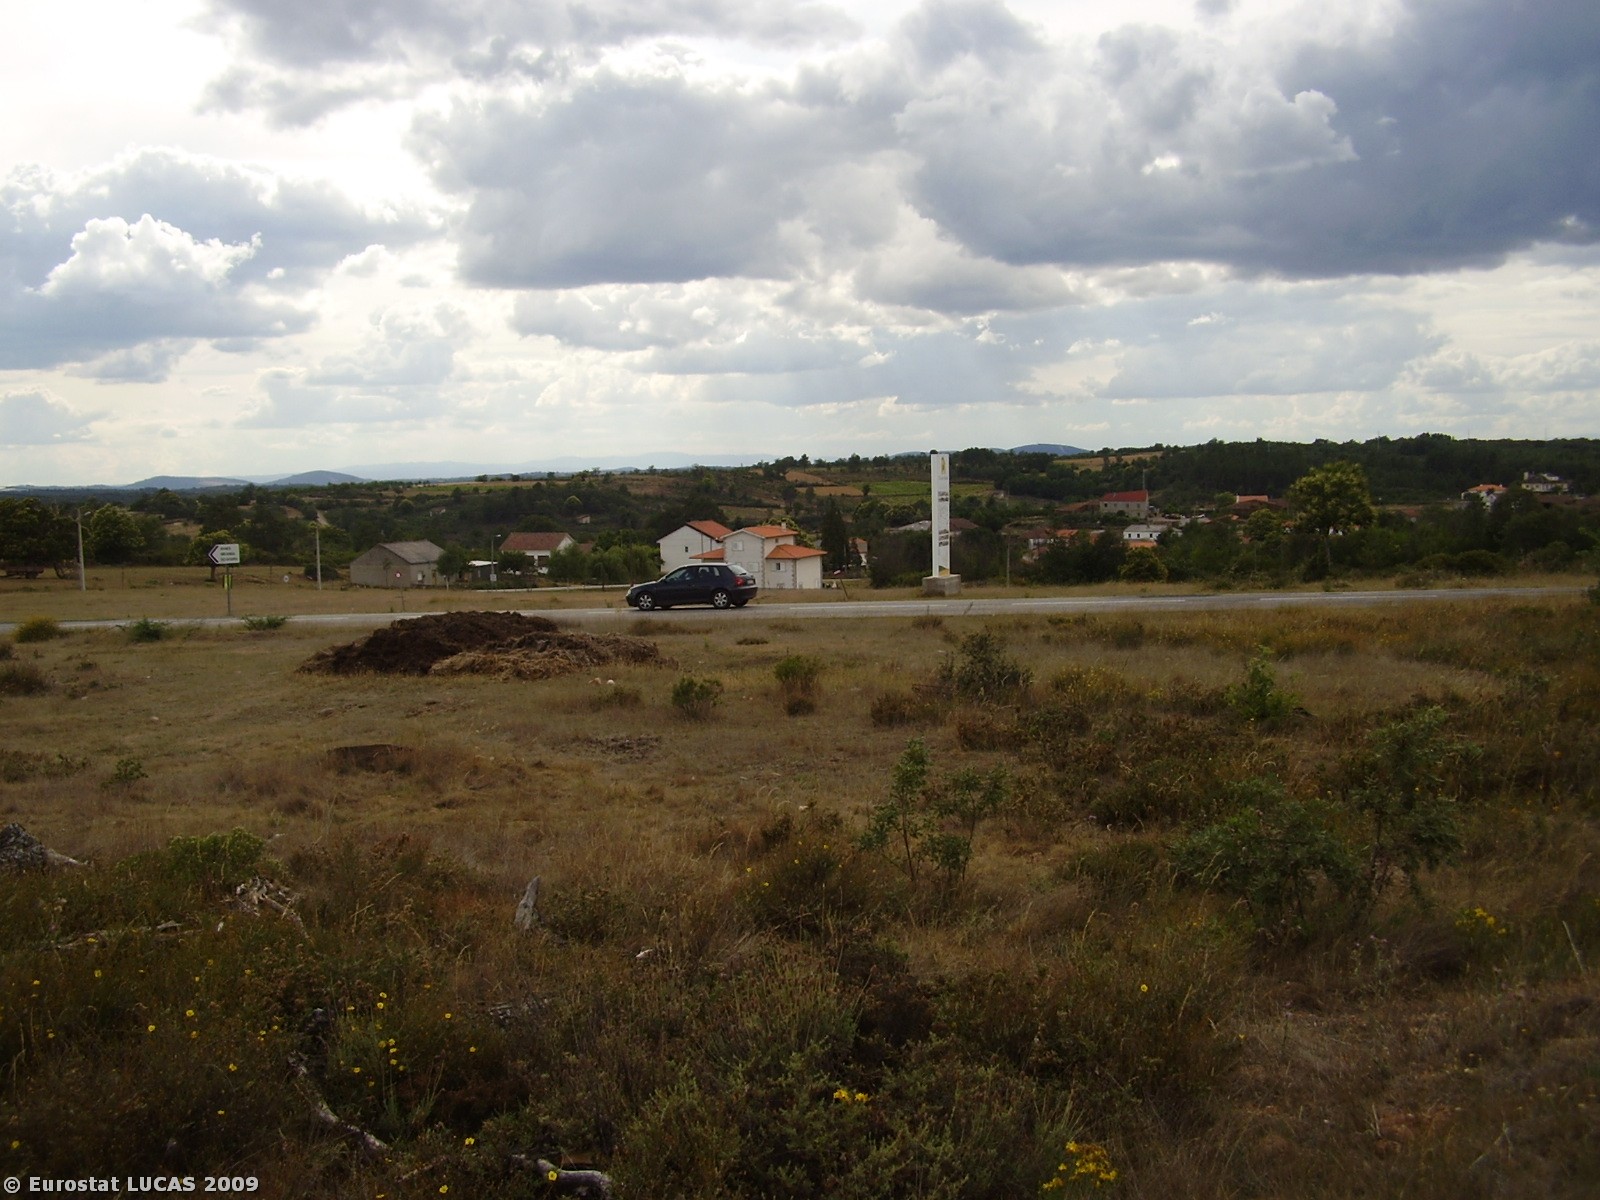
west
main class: Grassland
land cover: Spontaneously vegetated surfaces
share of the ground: > 75 %
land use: Unused
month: June
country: PT
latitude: 41.6230
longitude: -6.2662
